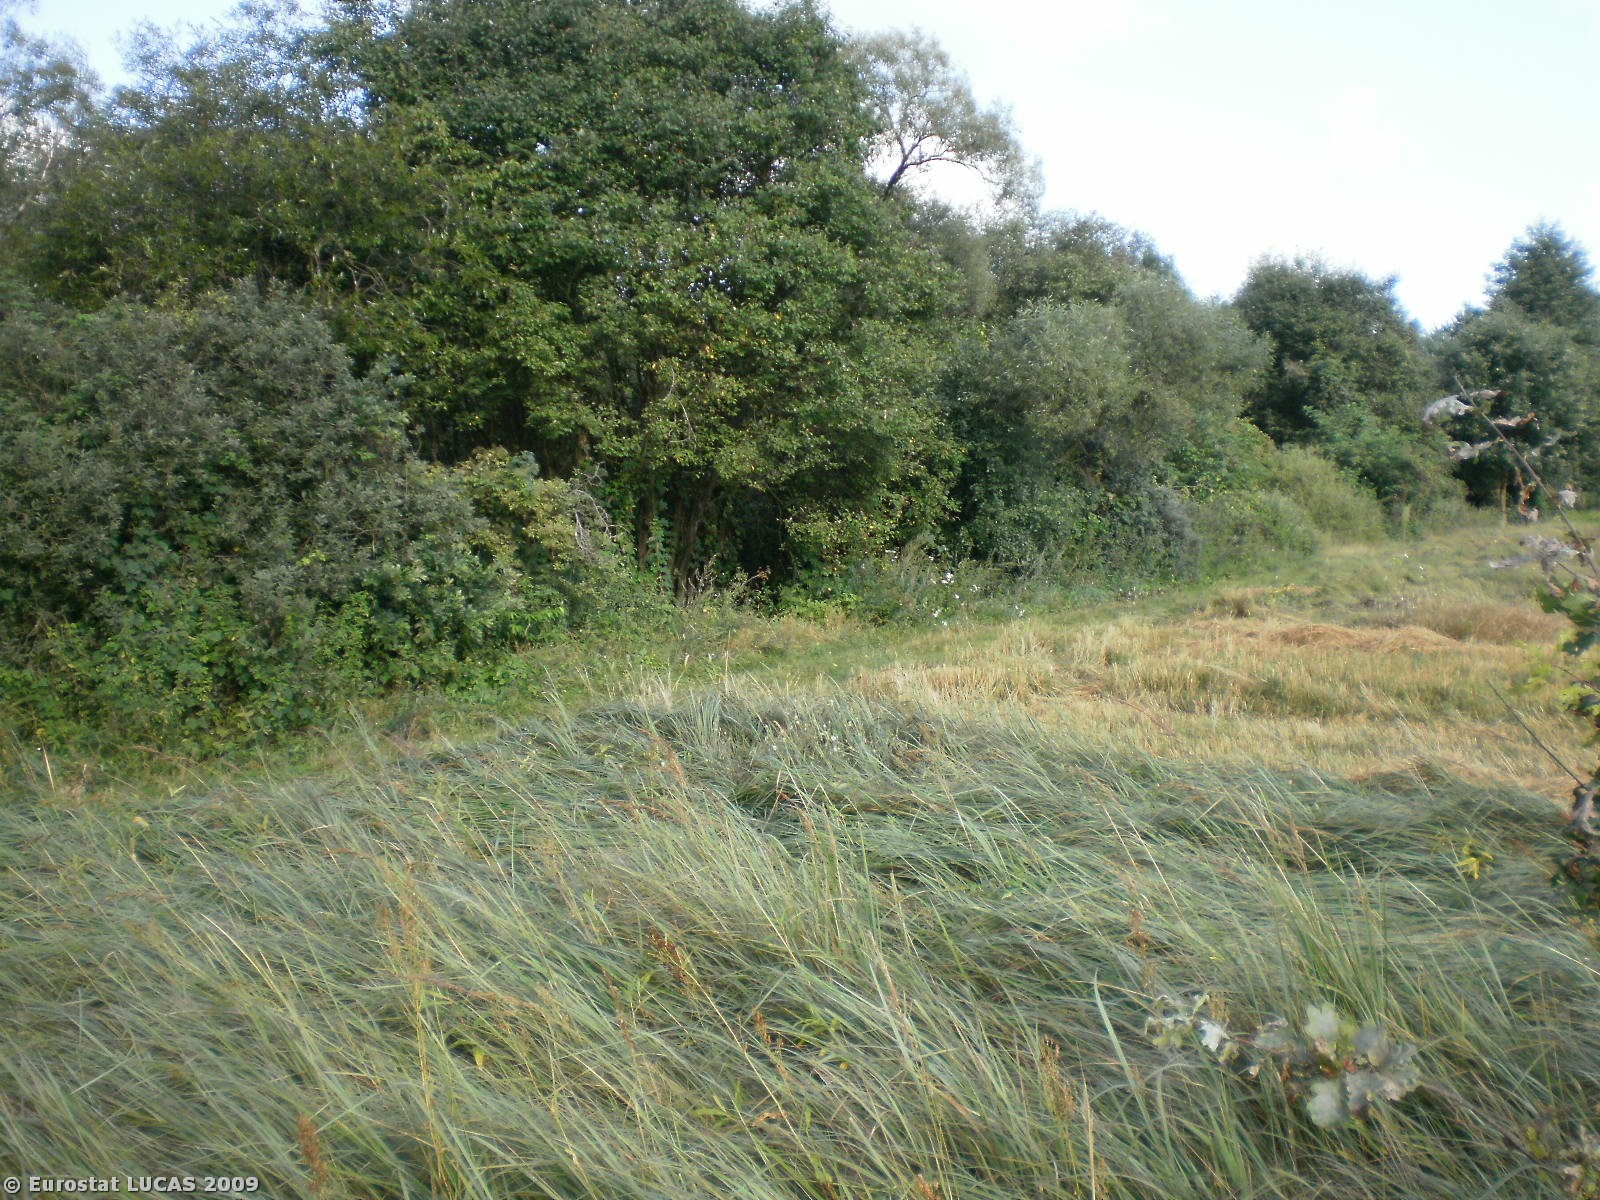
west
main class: Grassland
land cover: Grassland with sparse tree/shrub cover
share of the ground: > 75 %
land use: Nature reserves
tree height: > 5 m
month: August
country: PL
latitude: 52.7232
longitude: 21.1355
